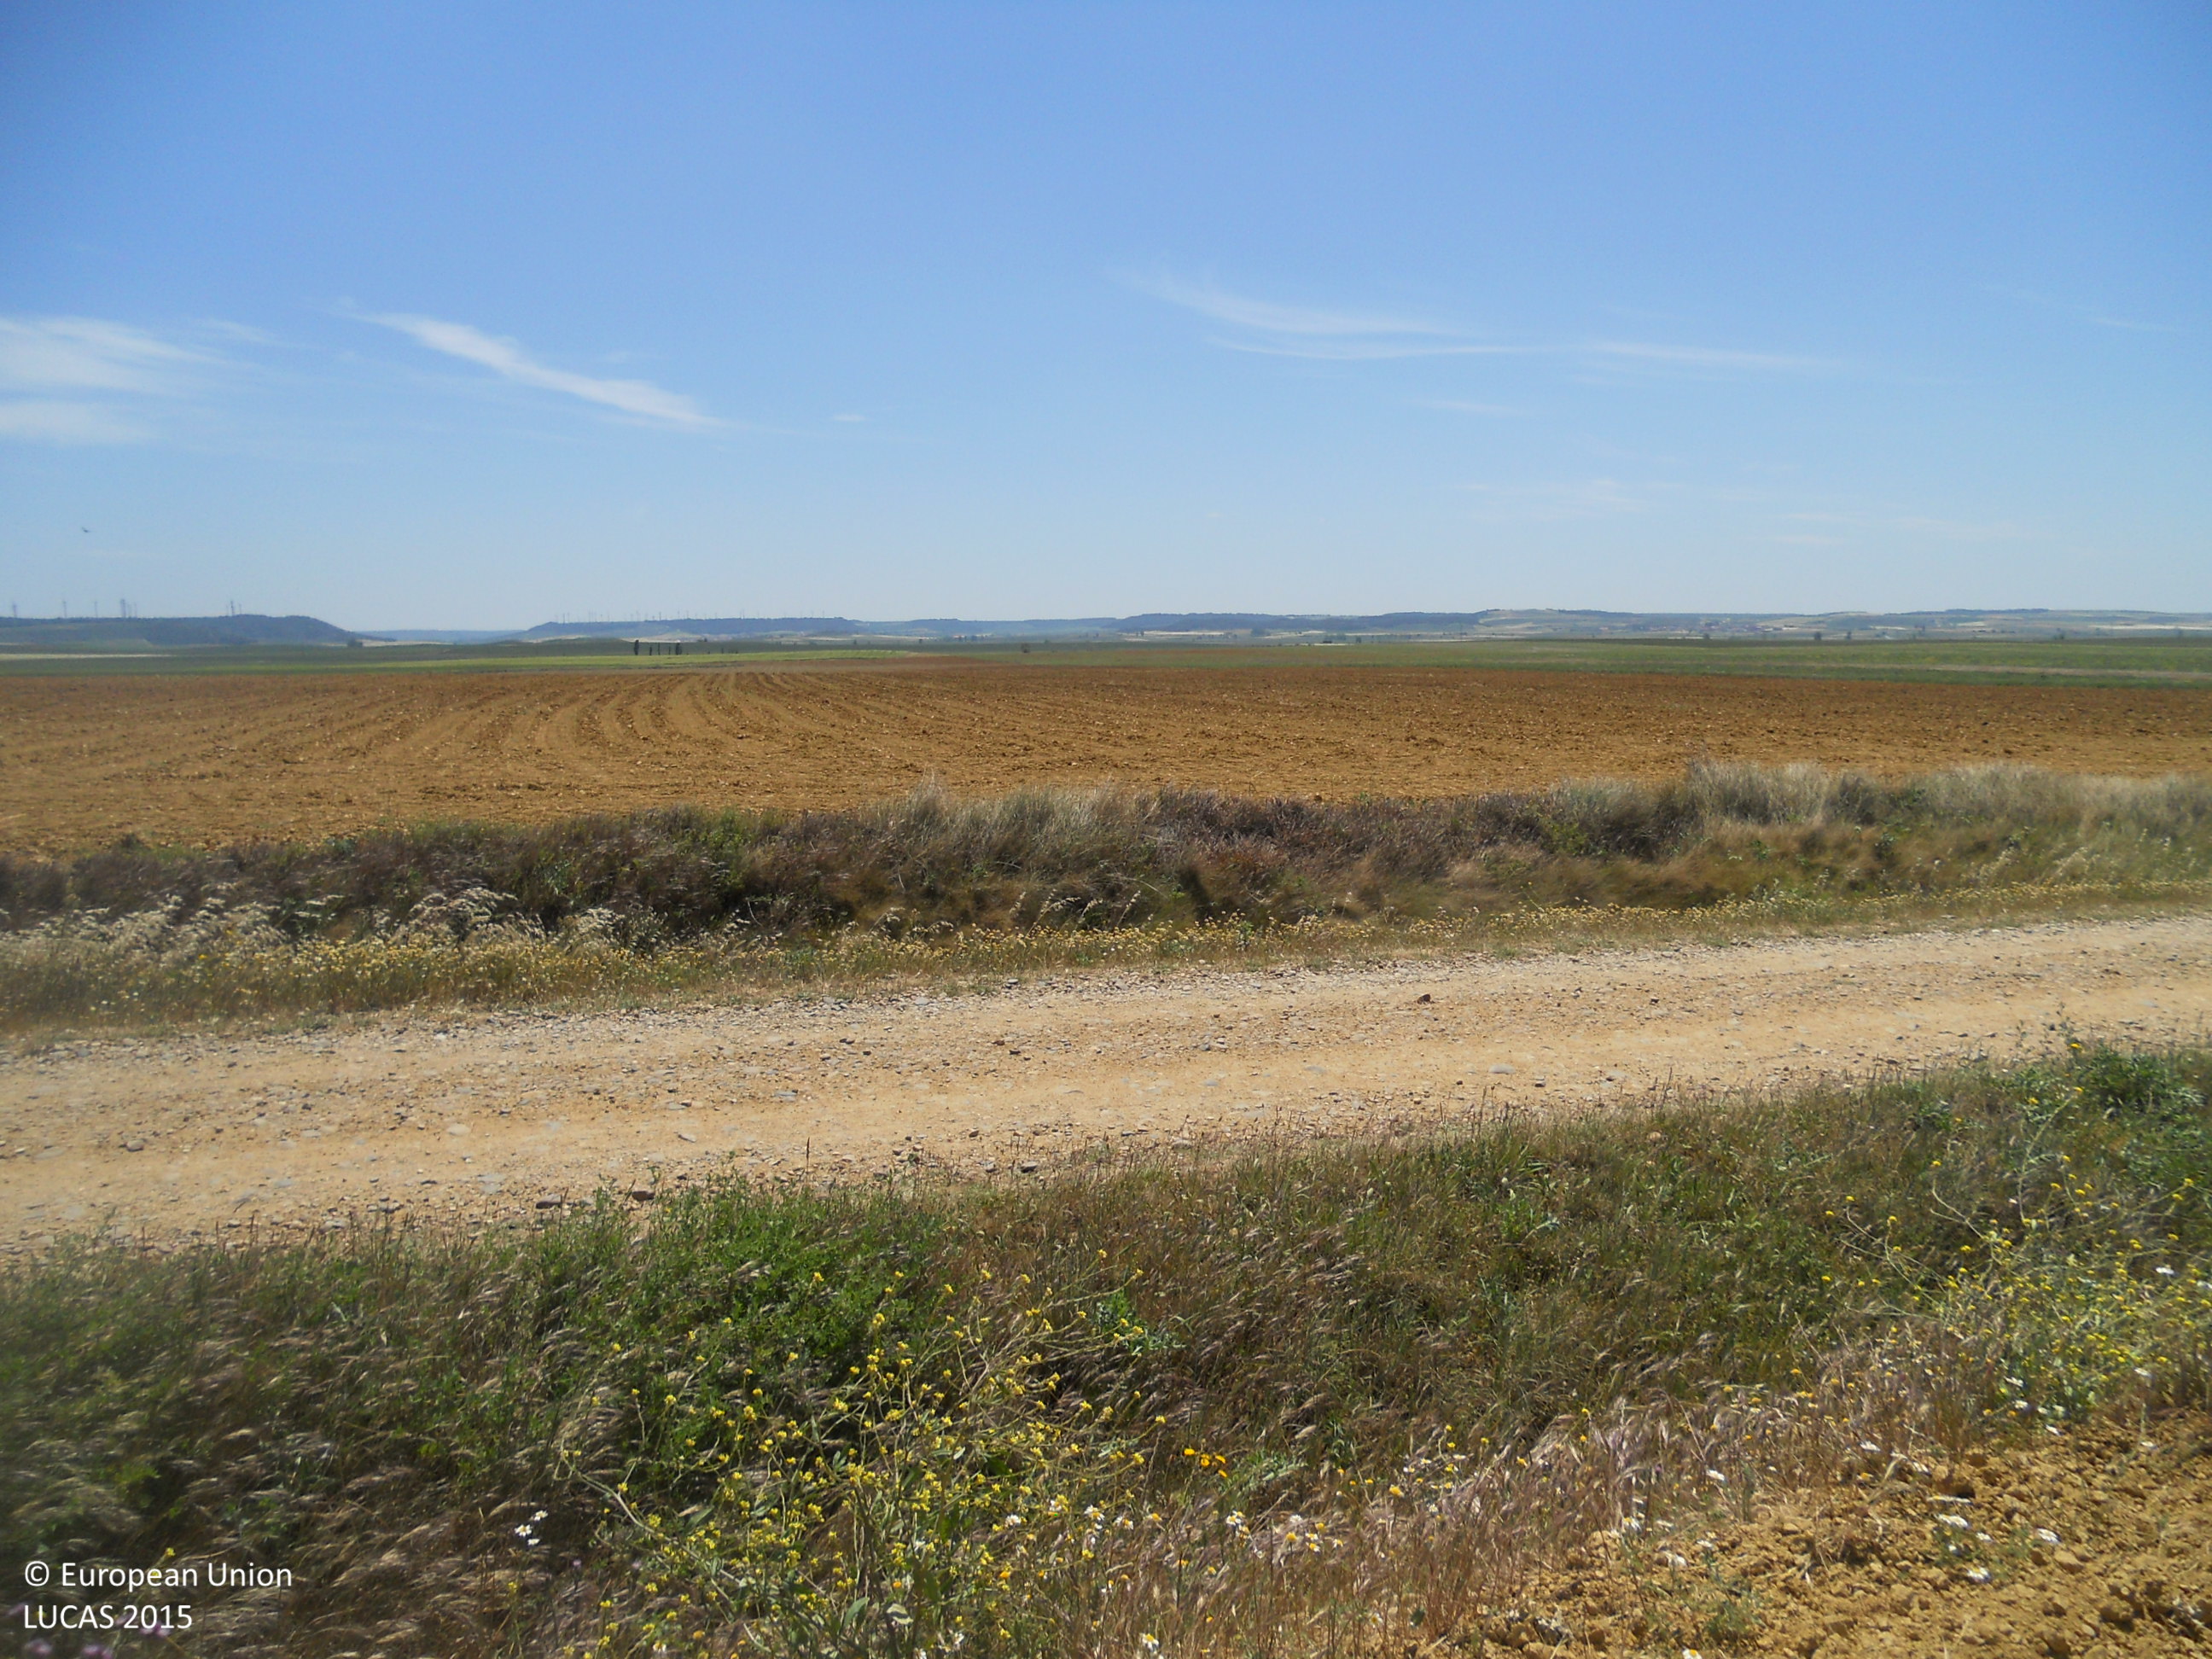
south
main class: Cropland
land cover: Sunflower
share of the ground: < 10 %
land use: Agriculture (excluding fallow land and kitchen gardens)
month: May
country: ES
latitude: 42.2720
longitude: -4.3160
